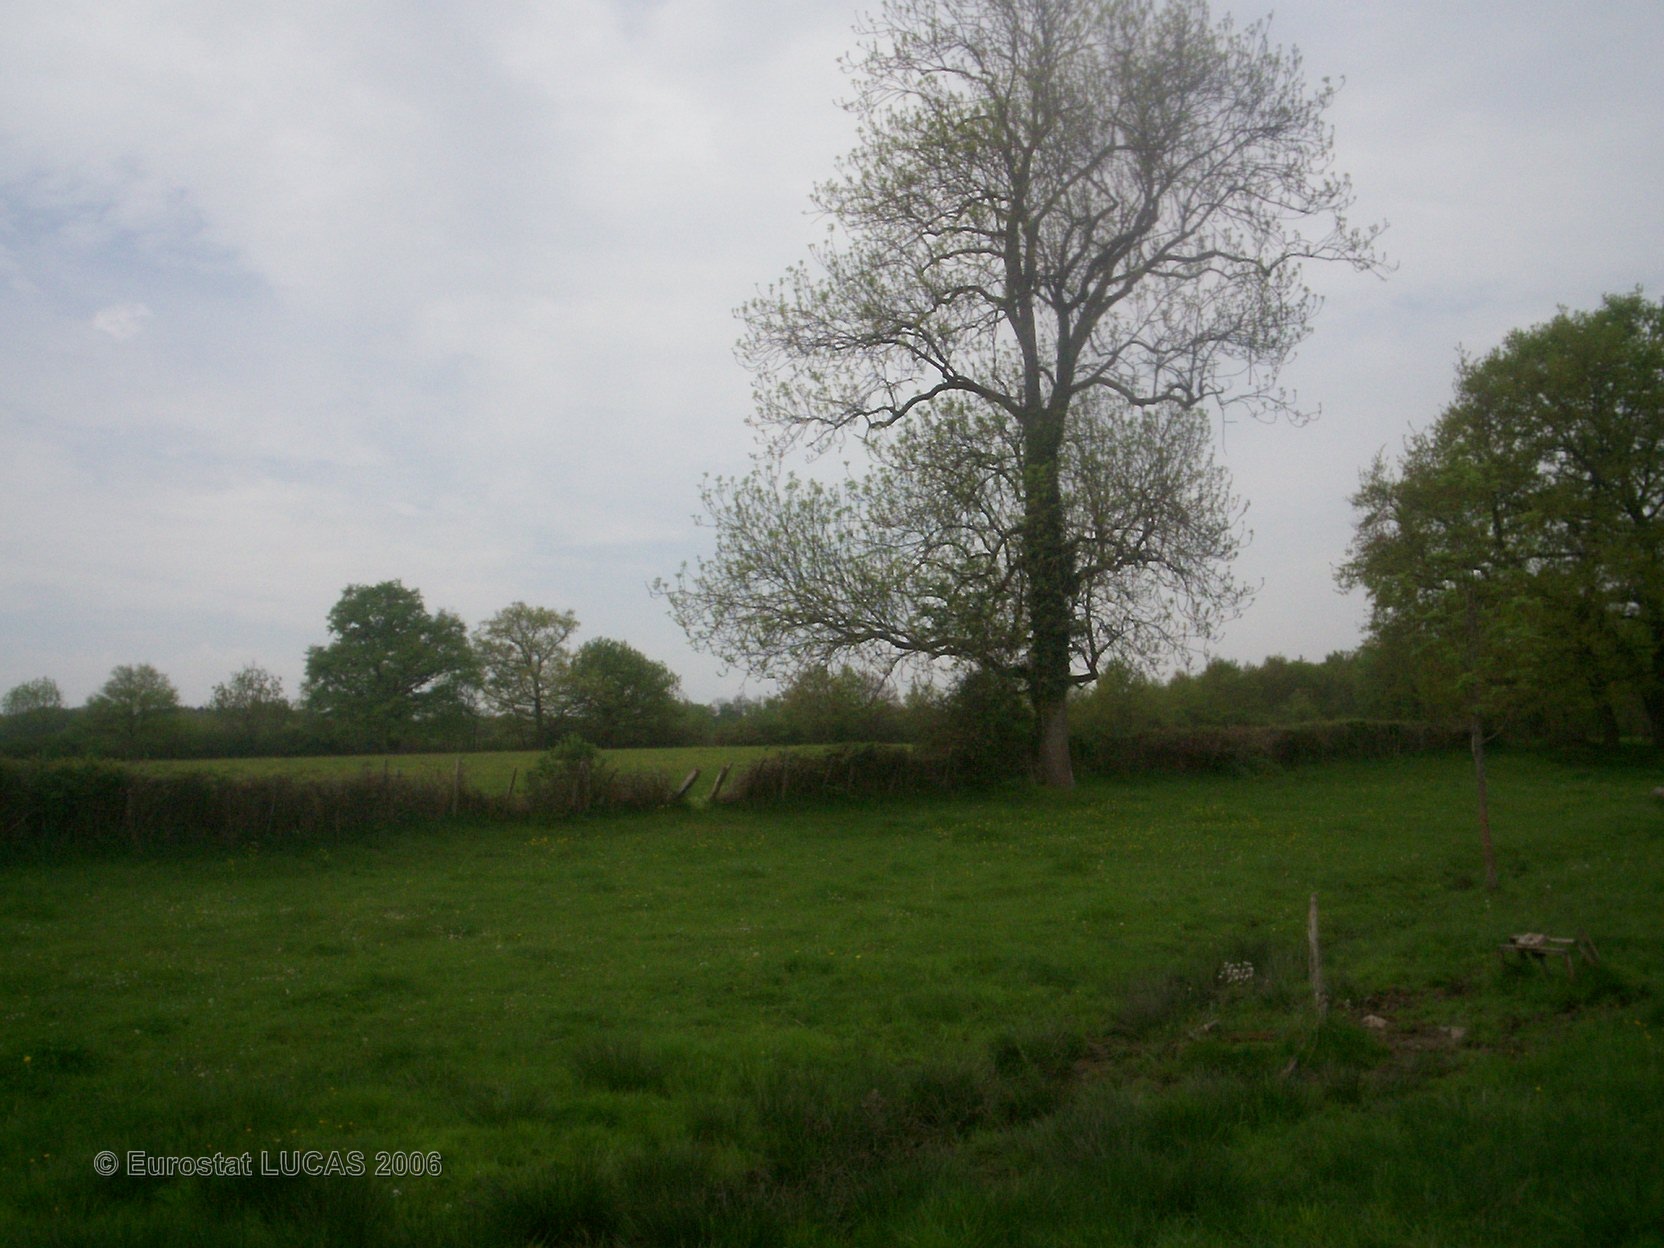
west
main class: Grassland
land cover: Grassland with sparse tree/shrub cover
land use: Agriculture (excluding fallow land and kitchen gardens)
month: May
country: FR
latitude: 46.0370
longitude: 3.0861
